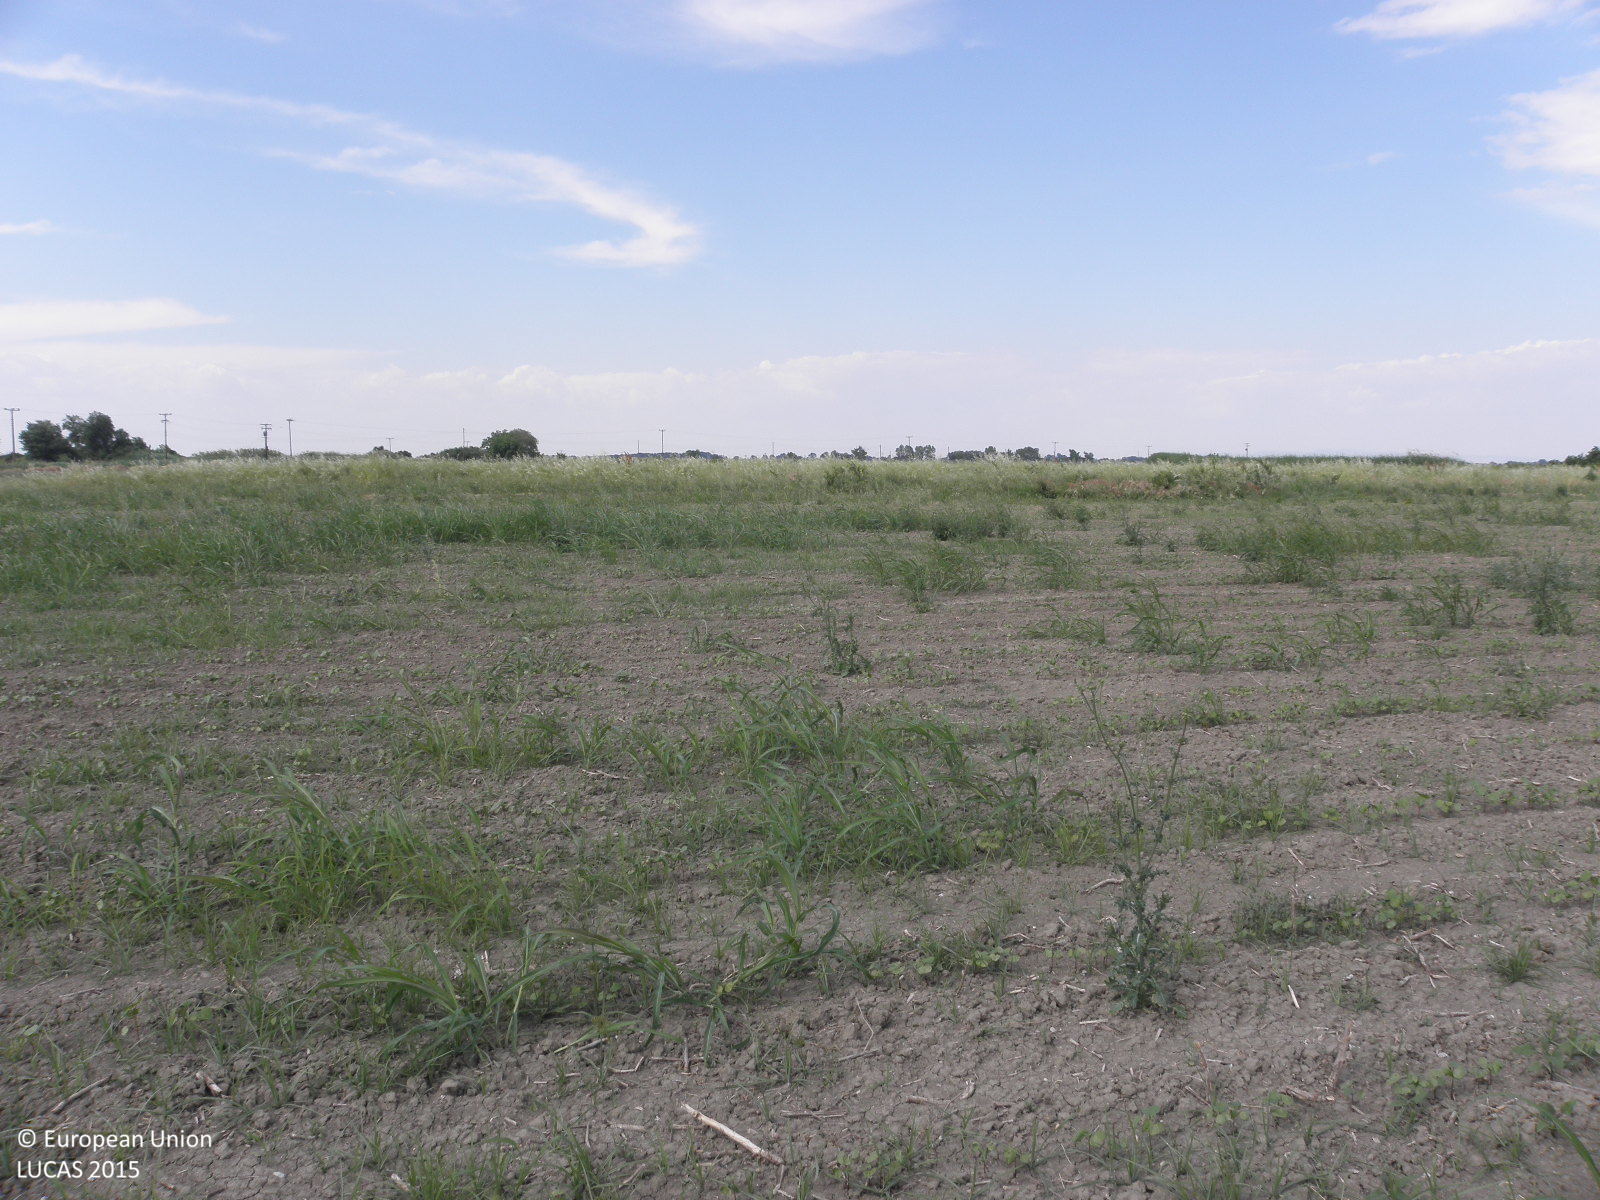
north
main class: Cropland
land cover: Common wheat
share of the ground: > 75 %
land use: Agriculture (excluding fallow land and kitchen gardens)
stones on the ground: < 10 %
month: June
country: GR
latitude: 40.5187
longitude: 22.5481
